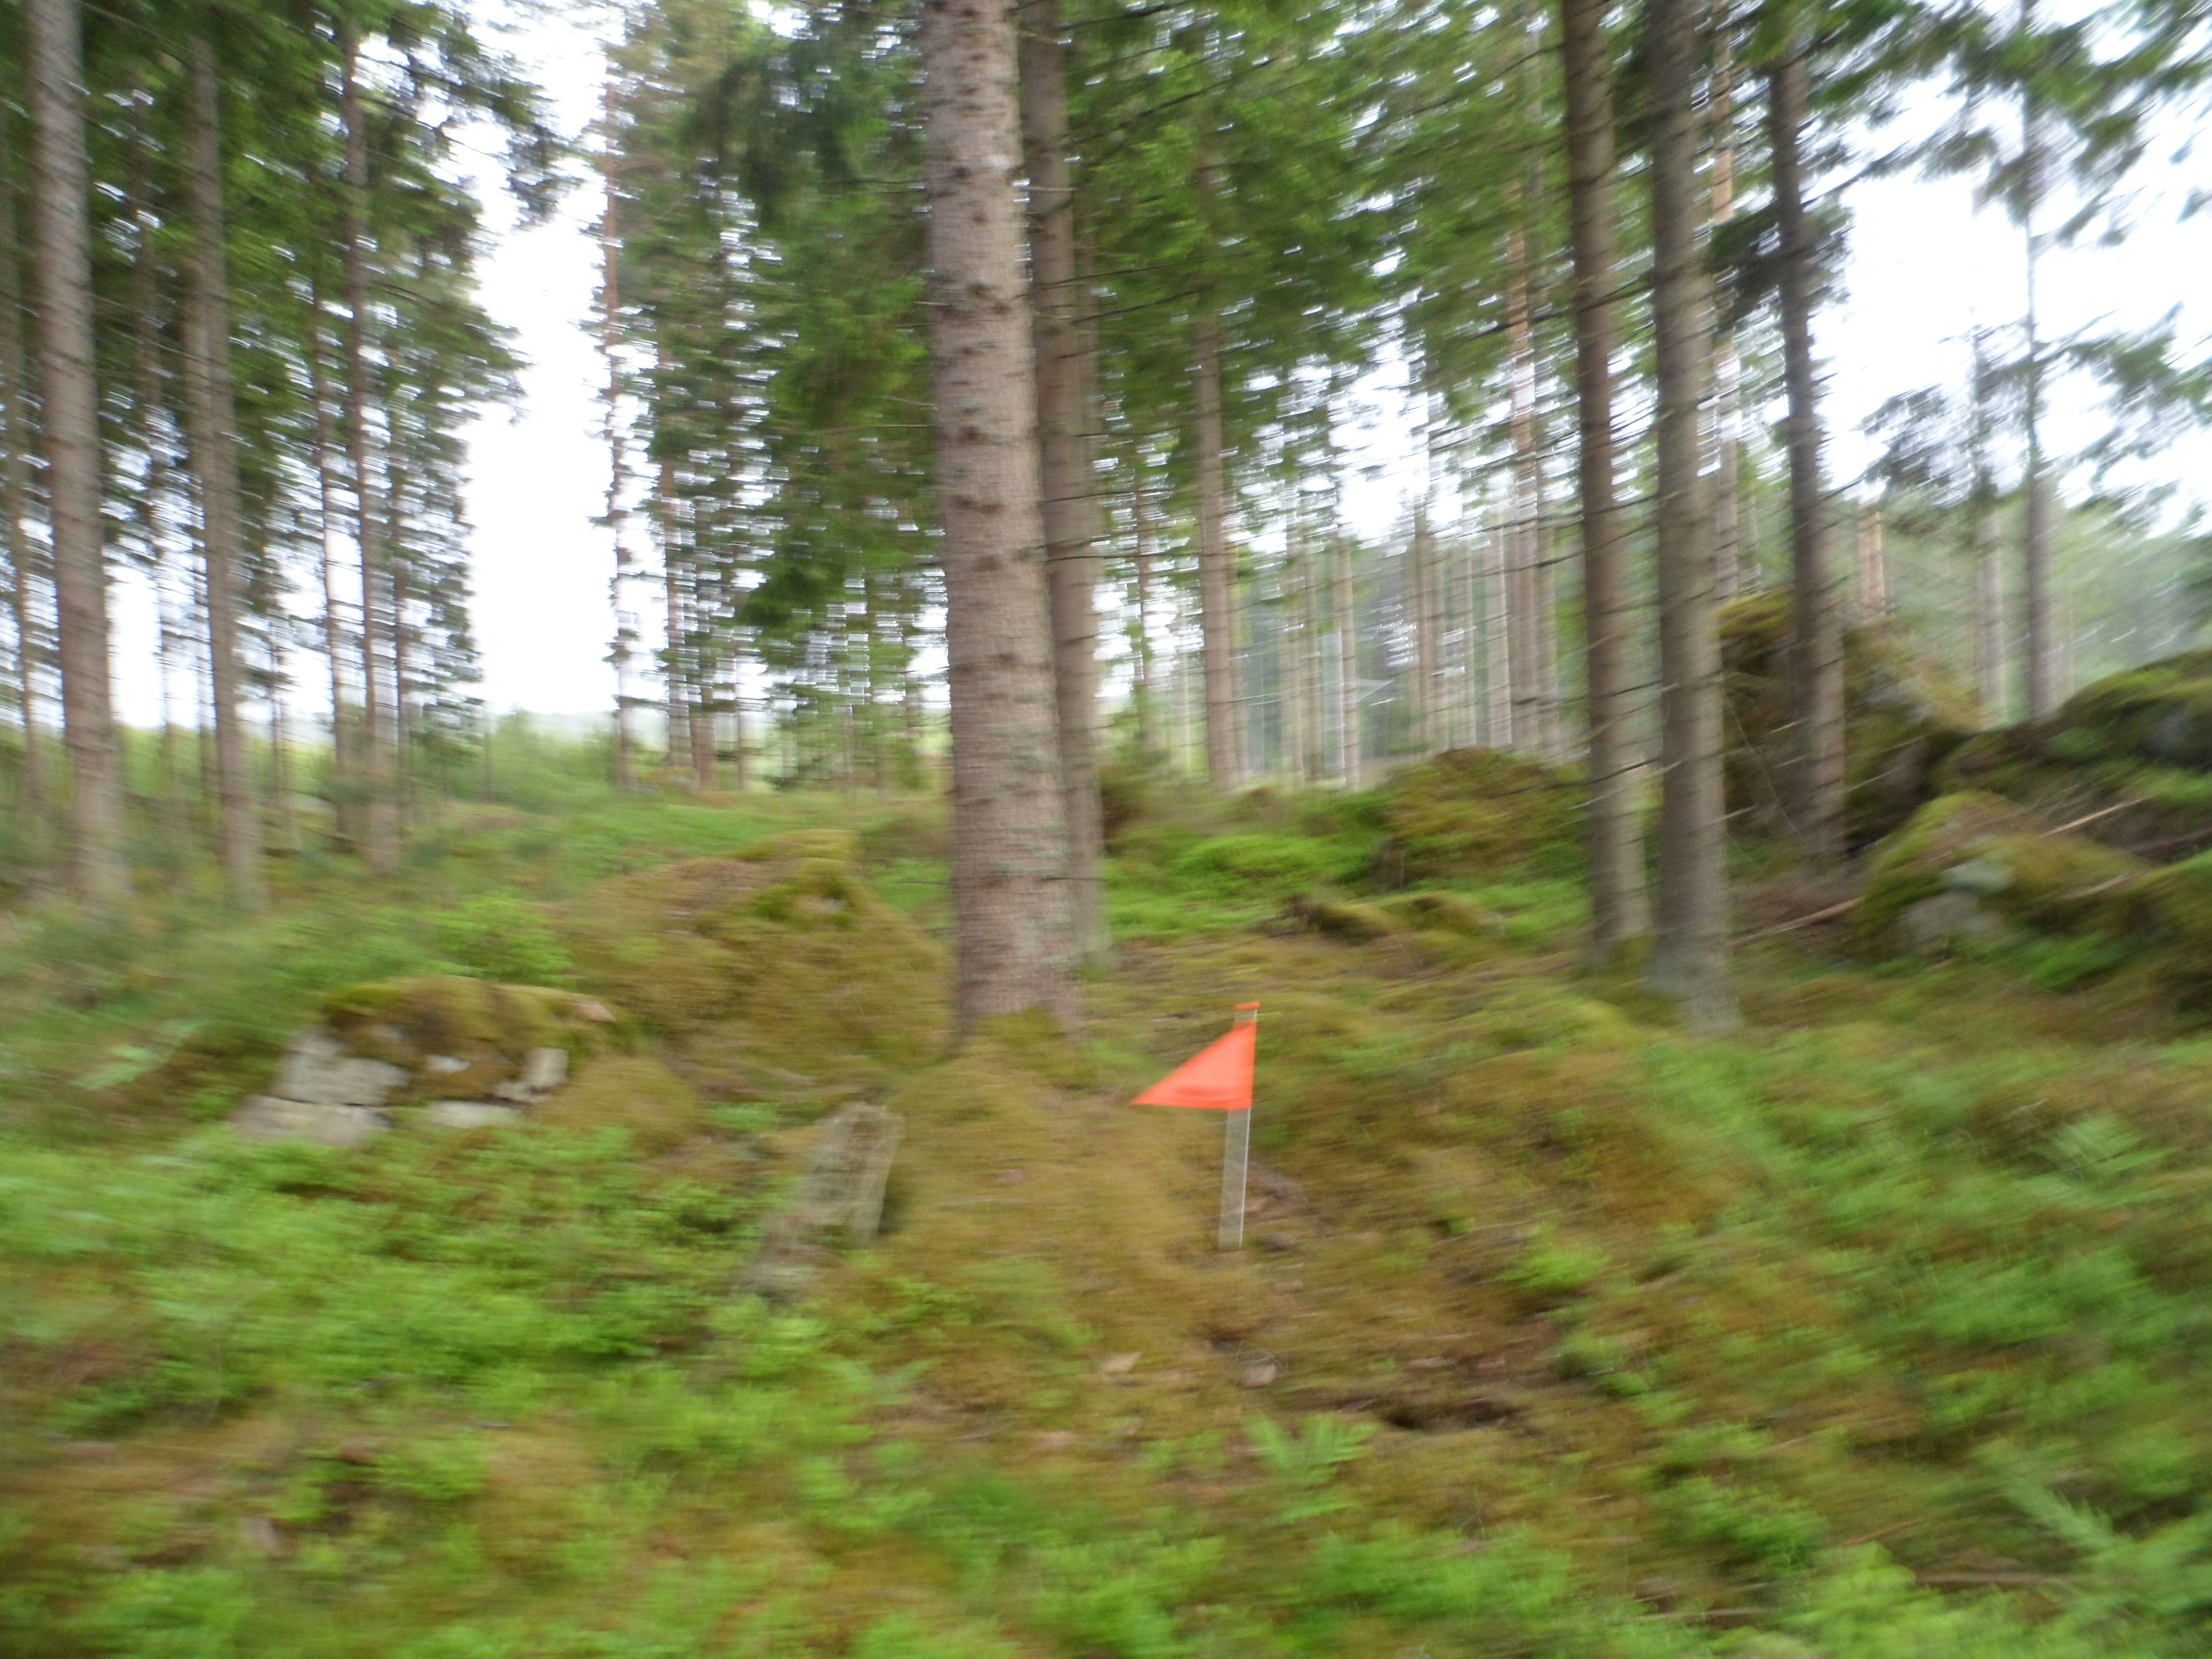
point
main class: Woodland
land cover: Spruce dominated coniferous woodland
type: boreal forest
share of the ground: 50 - 75 %
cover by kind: coniferous forest trees 55 %, shrubs 25 %, lichens and mosses 10 %, broadleaved forest trees 5 %, herbaceous plants 5 %
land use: Forestry
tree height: > 5 m
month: June
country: SE
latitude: 56.8795
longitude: 14.6080
